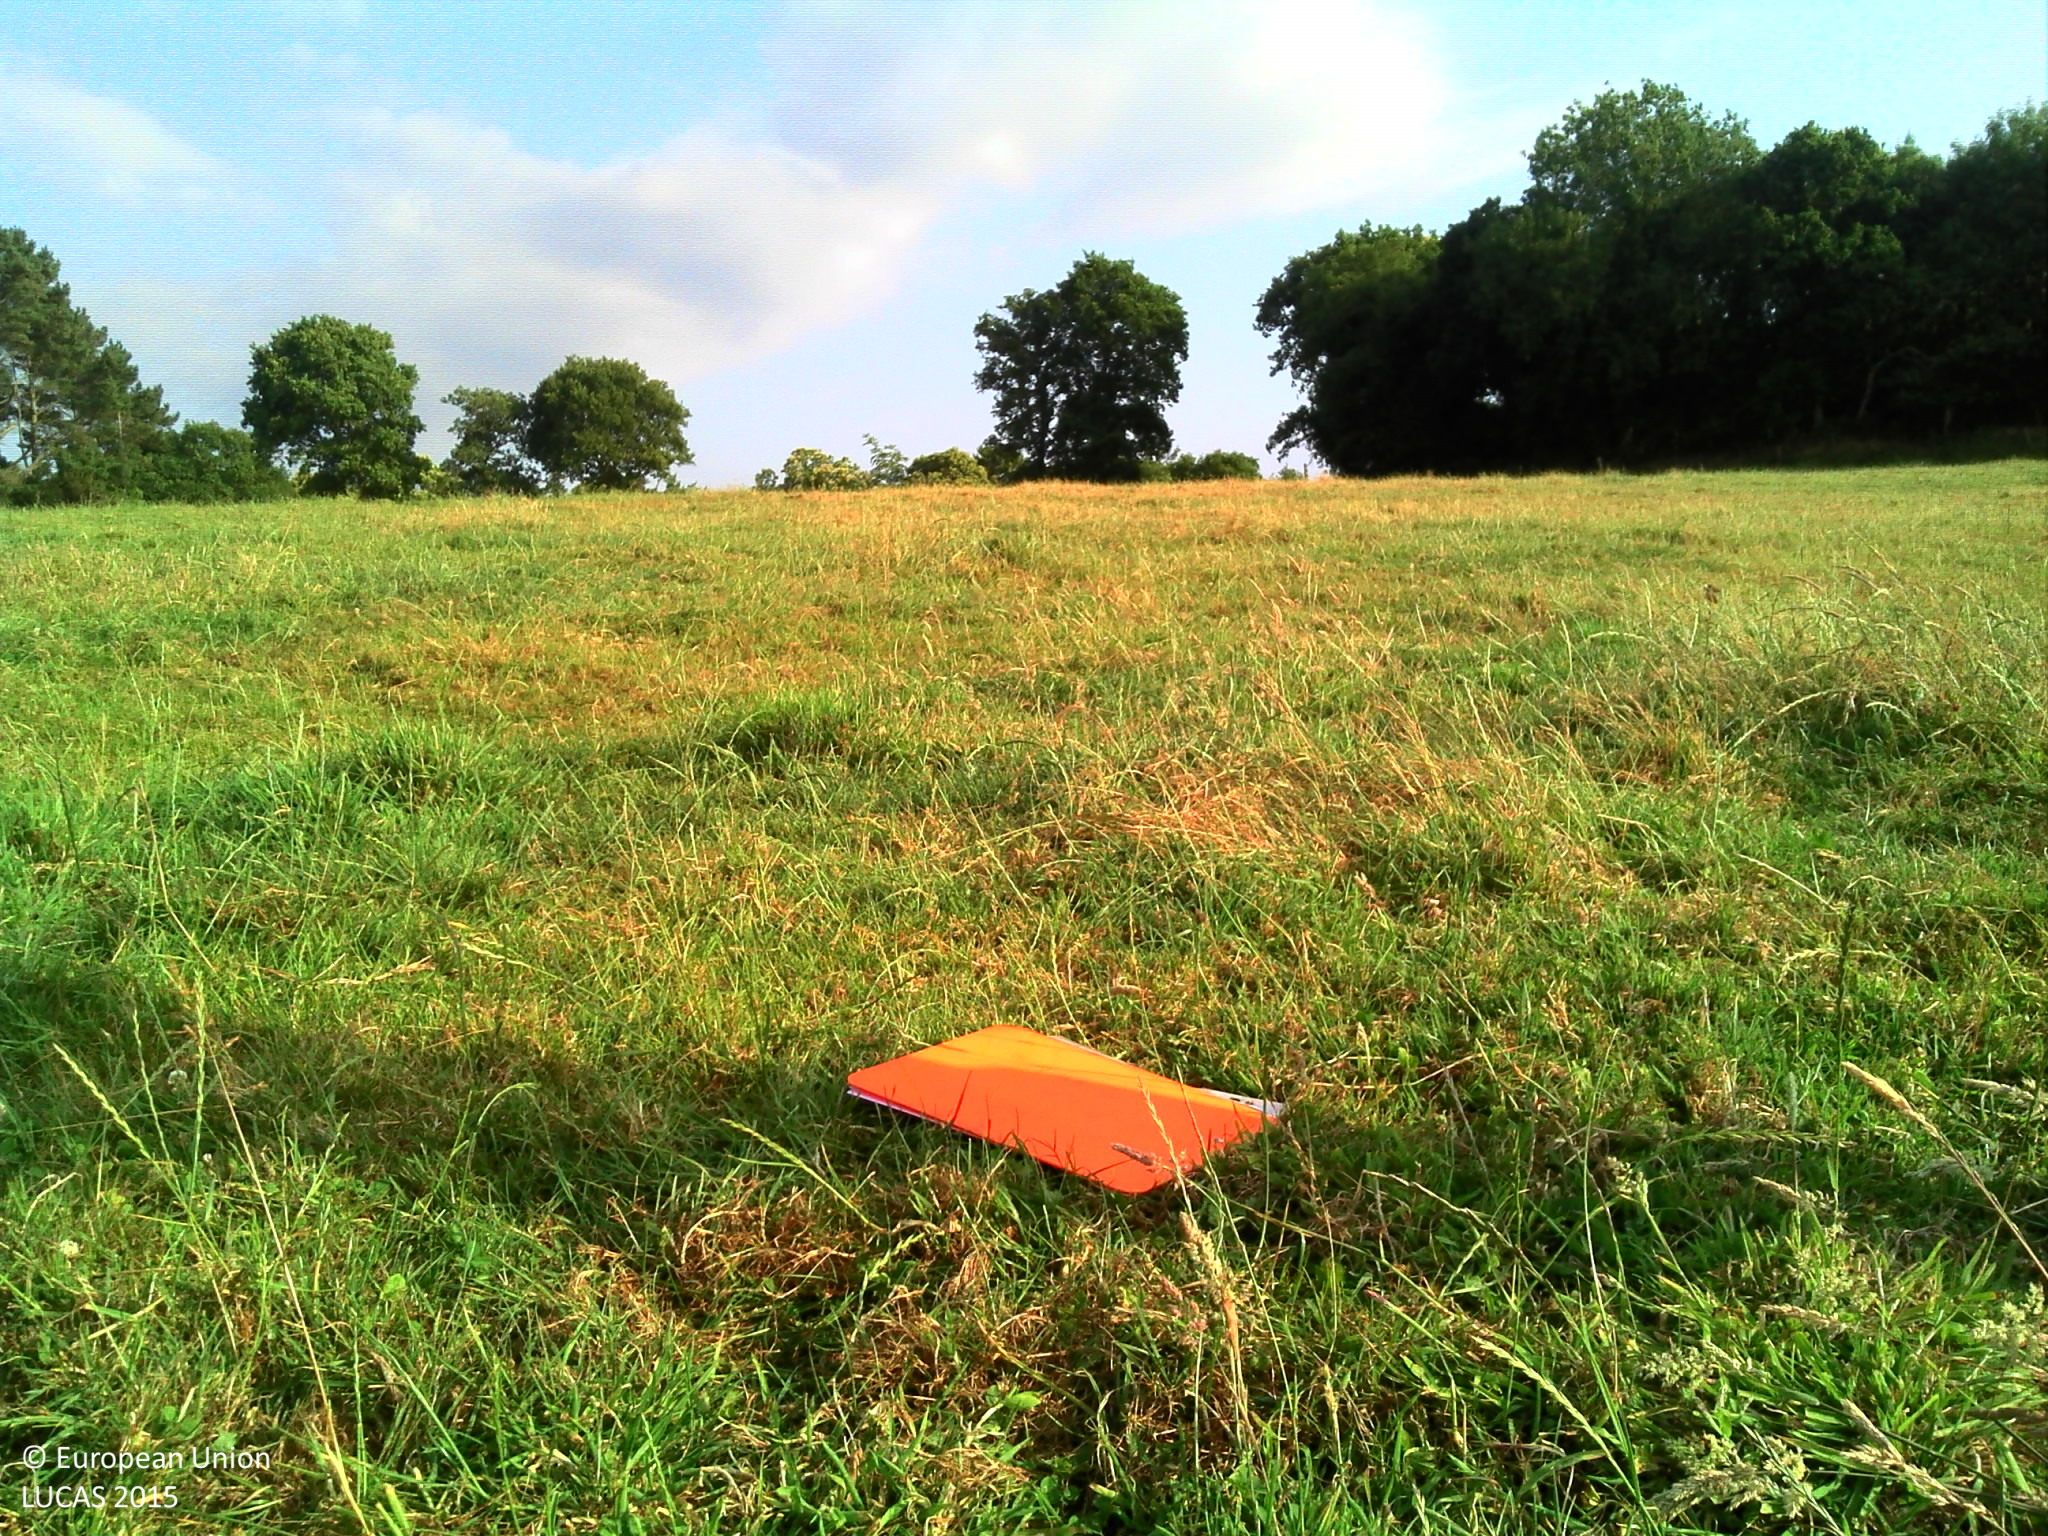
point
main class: Grassland
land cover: Grassland without tree/shrub cover
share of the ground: > 75 %
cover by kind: herbaceous plants 100 %
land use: Agriculture (excluding fallow land and kitchen gardens)
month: July
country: FR
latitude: 48.6885
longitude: -3.4593
